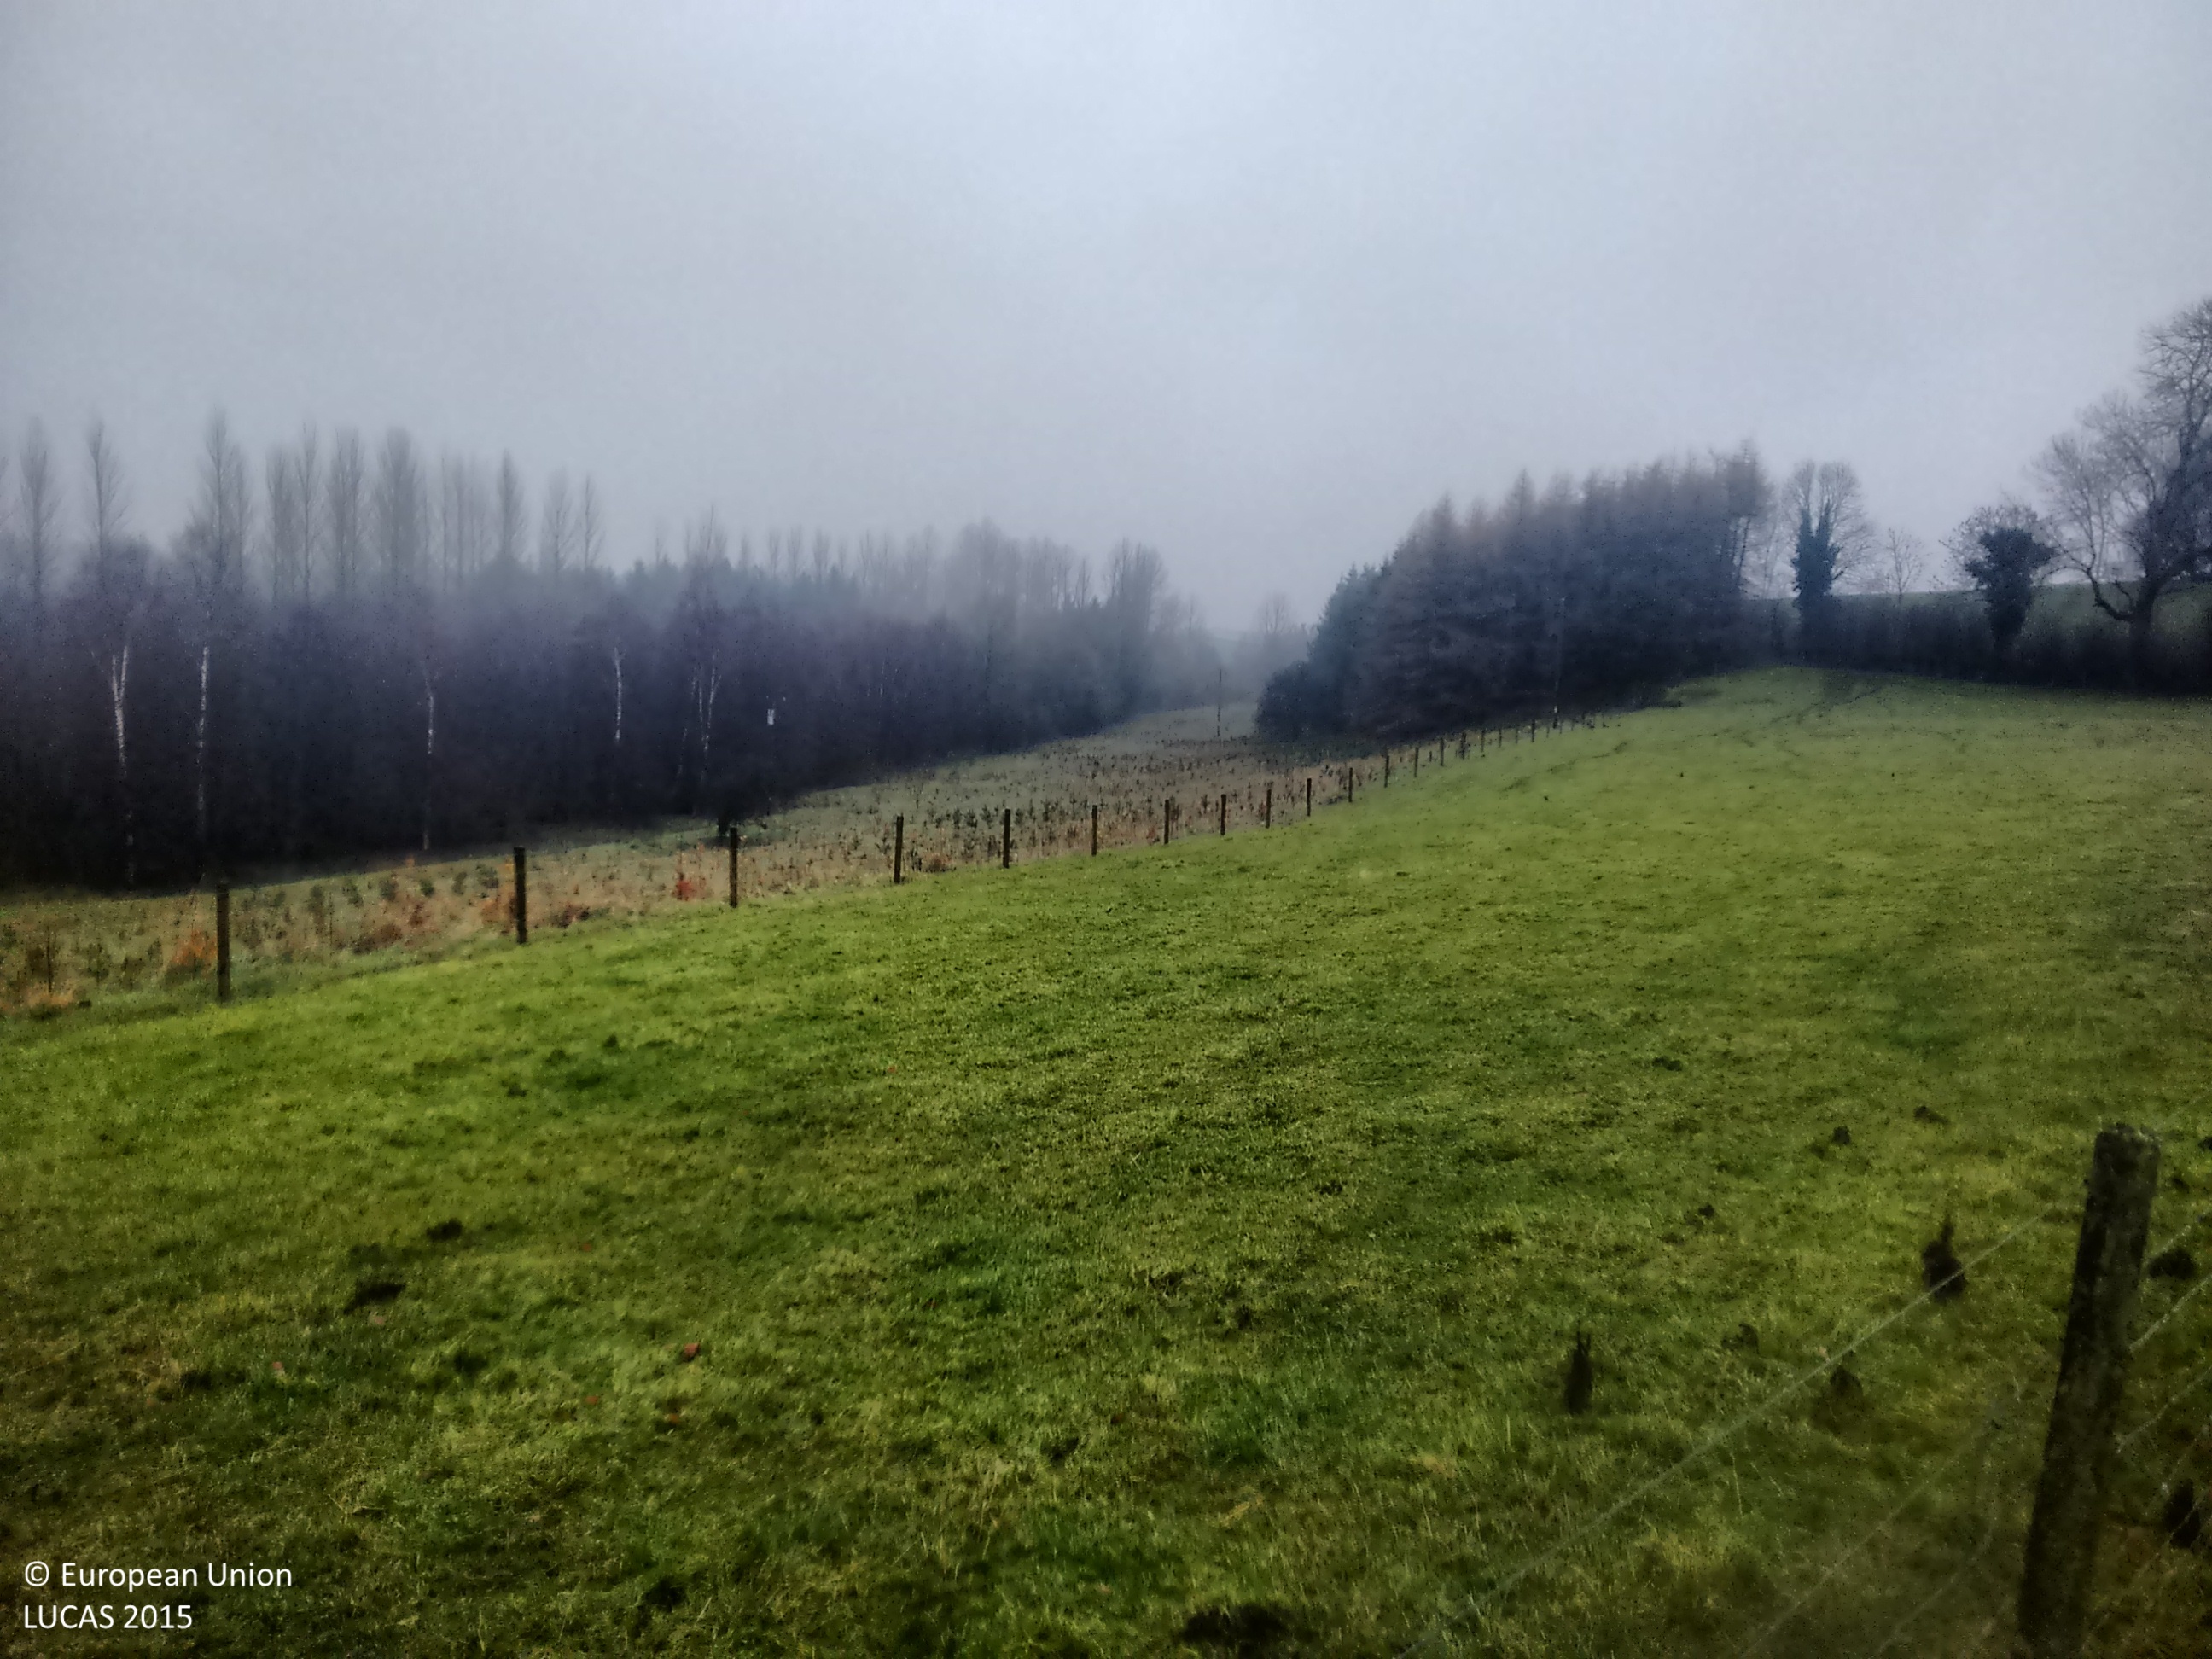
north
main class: Woodland
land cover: Other mixed woodland
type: boreal forest
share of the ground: > 75 %
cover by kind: broadleaved forest trees 60 %, coniferous forest trees 40 %
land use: Semi-natural and natural areas not in use
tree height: > 5 m
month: December
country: IE
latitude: 54.1398
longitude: -7.2463
